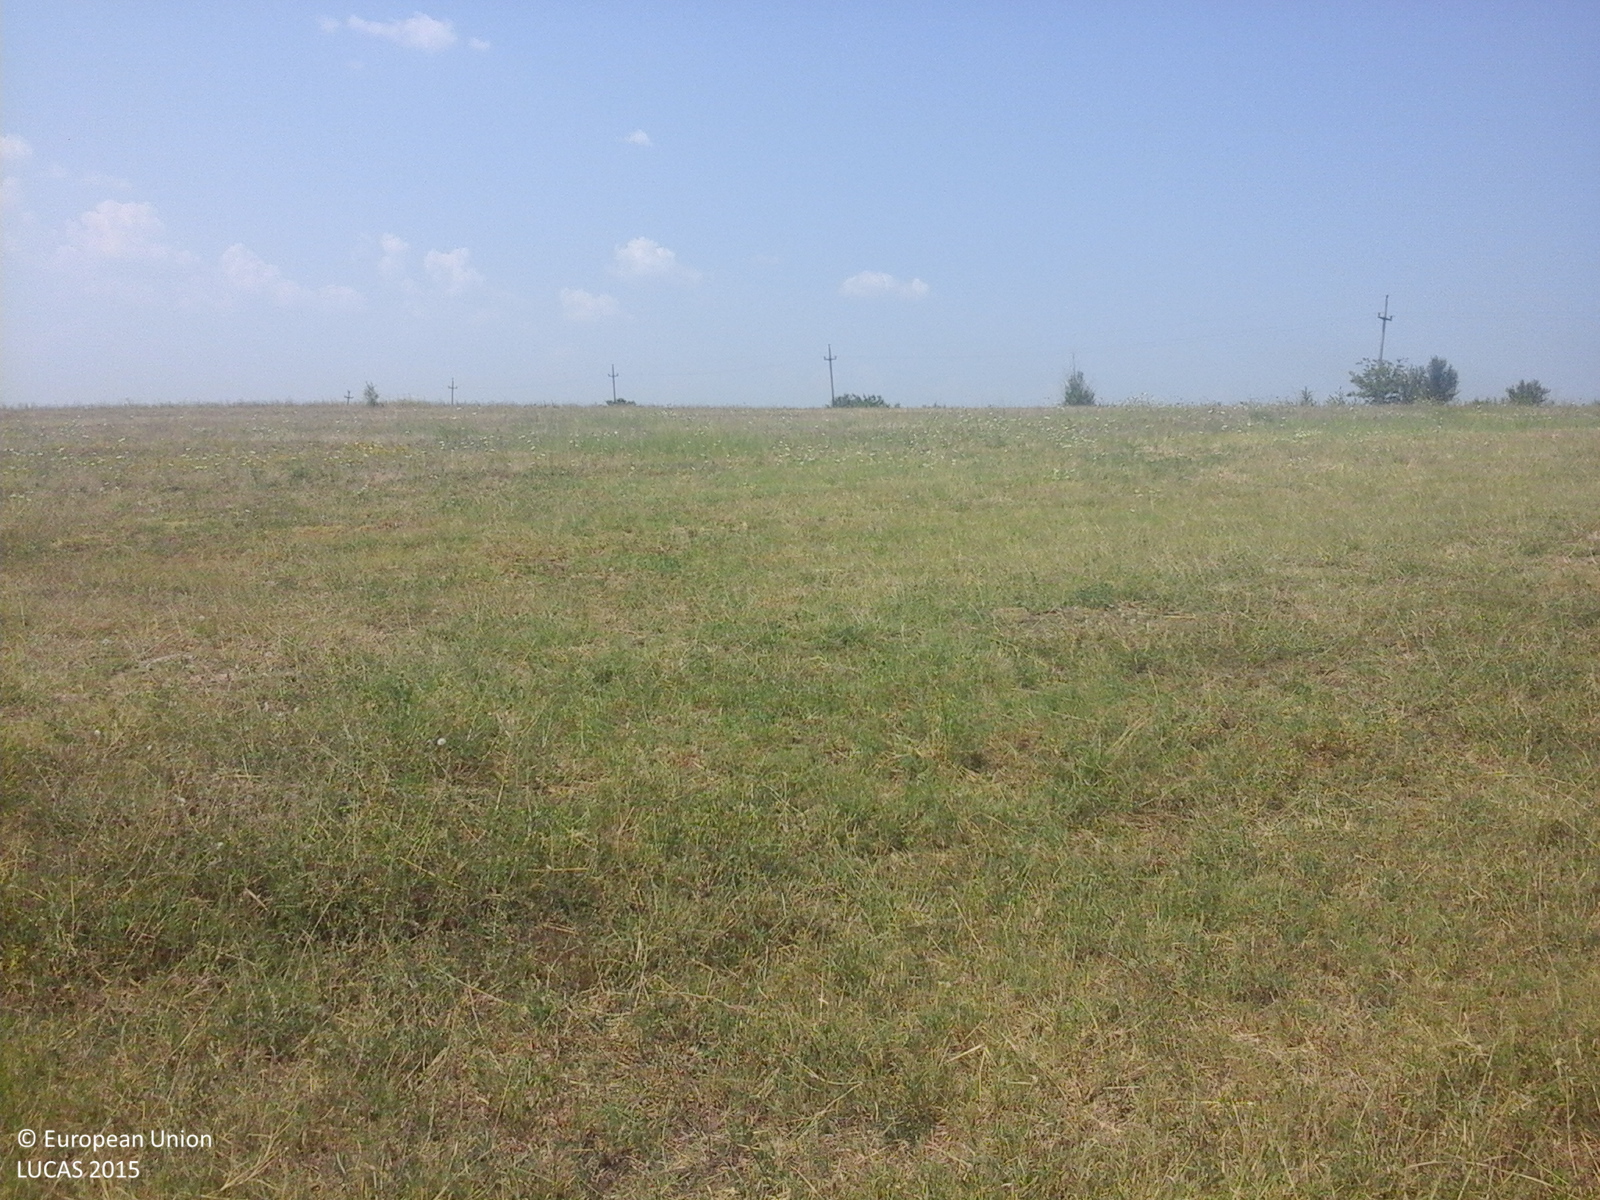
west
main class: Grassland
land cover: Grassland without tree/shrub cover
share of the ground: > 75 %
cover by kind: herbaceous plants 100 %
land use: Agriculture (excluding fallow land and kitchen gardens)
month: August
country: RO
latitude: 44.5112
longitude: 23.1684
